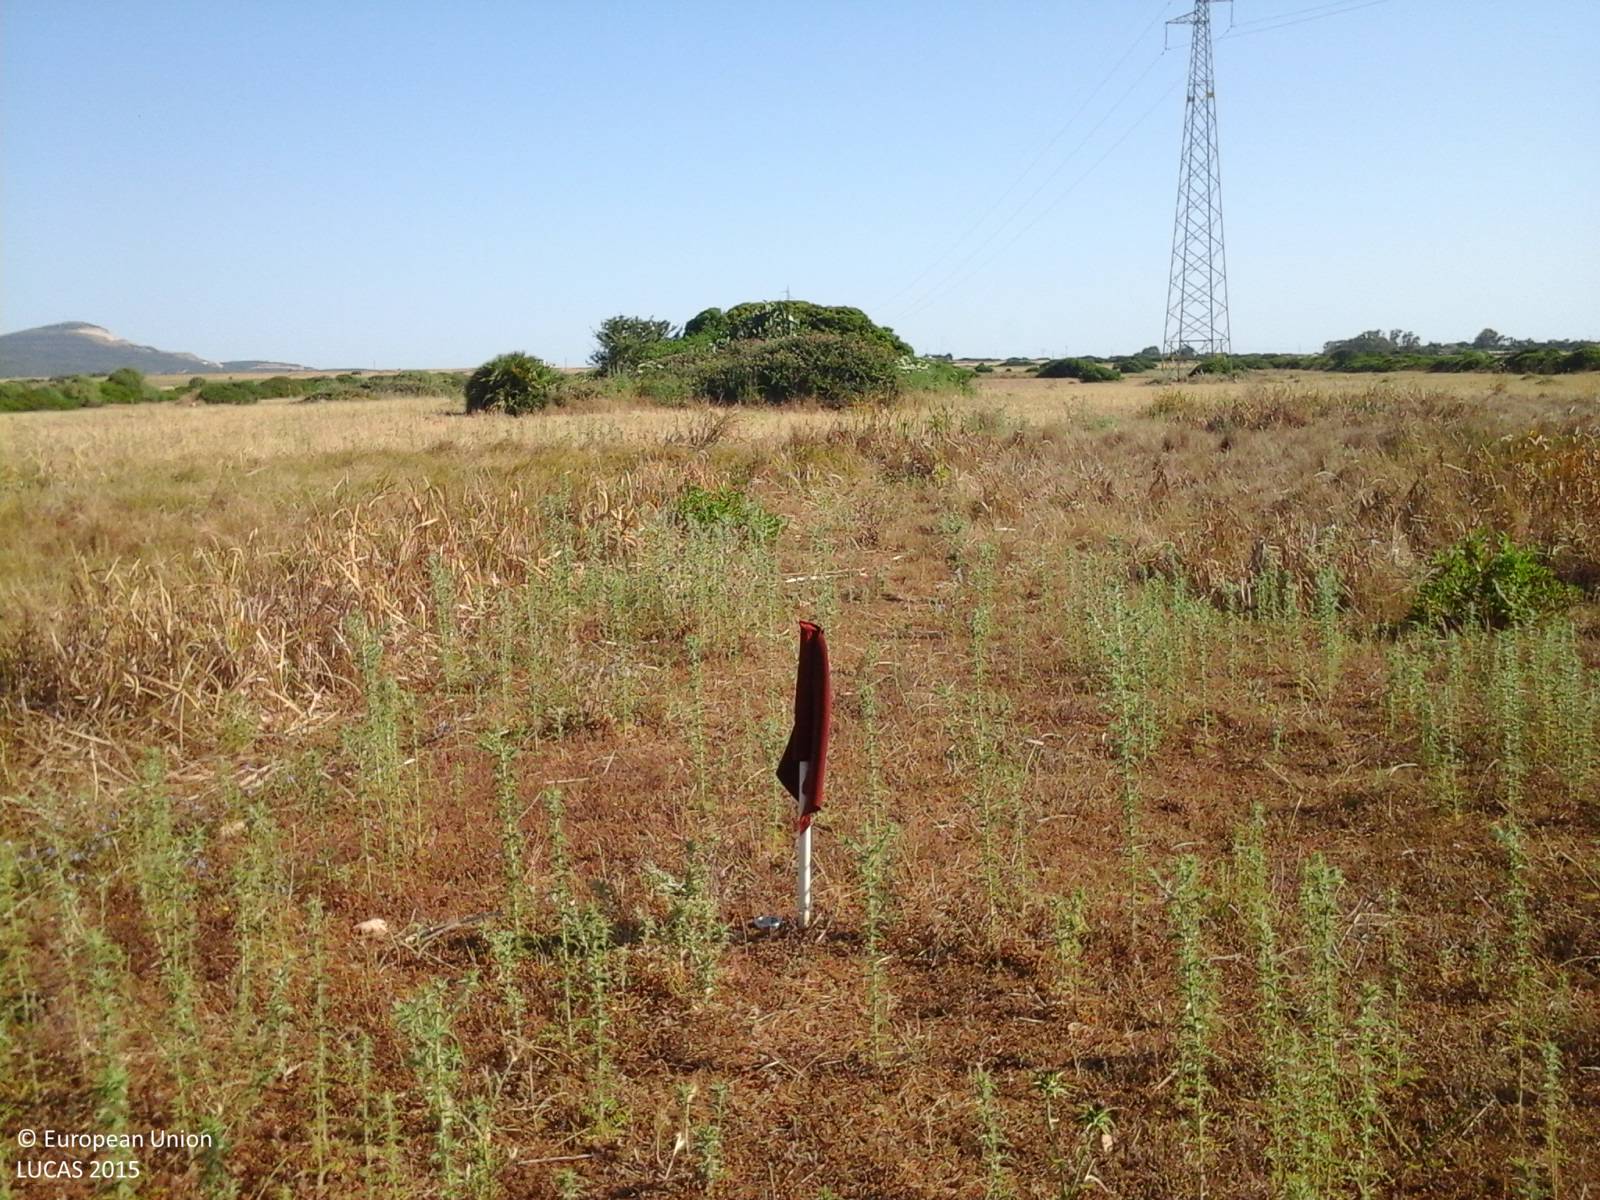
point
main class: Grassland
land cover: Spontaneously vegetated surfaces
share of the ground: > 75 %
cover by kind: herbaceous plants 95 %, shrubs 5 %
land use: Agriculture (excluding fallow land and kitchen gardens)
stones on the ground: < 10 %
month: June
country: IT
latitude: 40.7243
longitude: 8.3622
